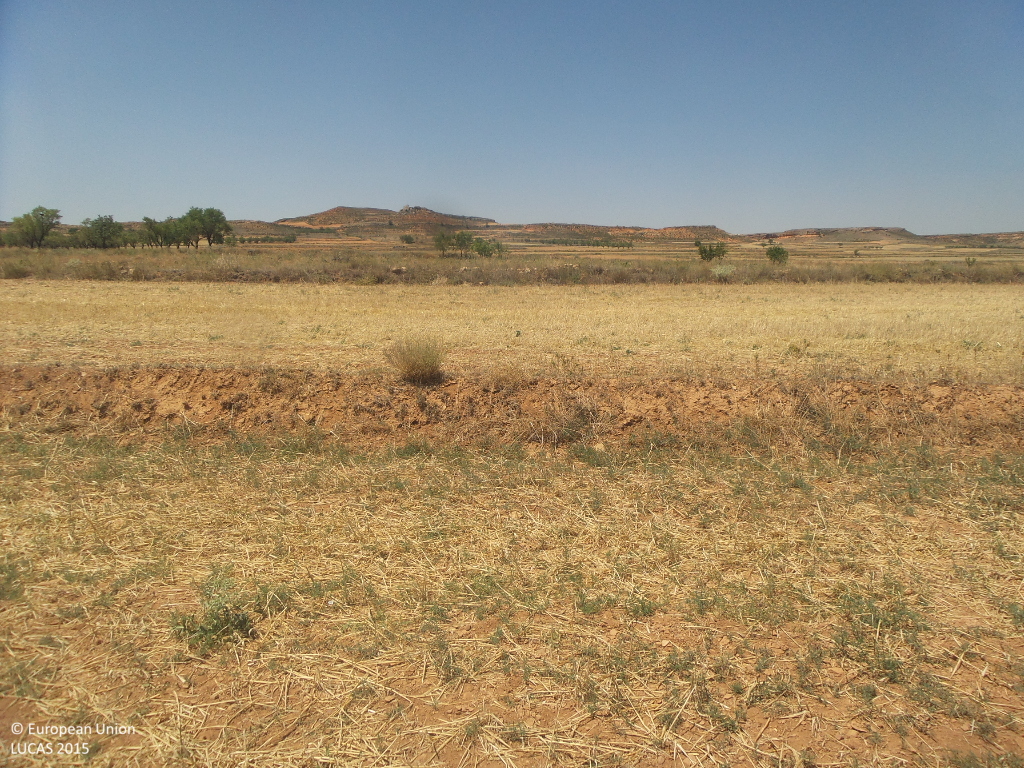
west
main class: Cropland
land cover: Barley
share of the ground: < 10 %
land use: Agriculture (excluding fallow land and kitchen gardens)
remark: Harvested field
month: July
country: ES
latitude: 41.2835
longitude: -1.9795
